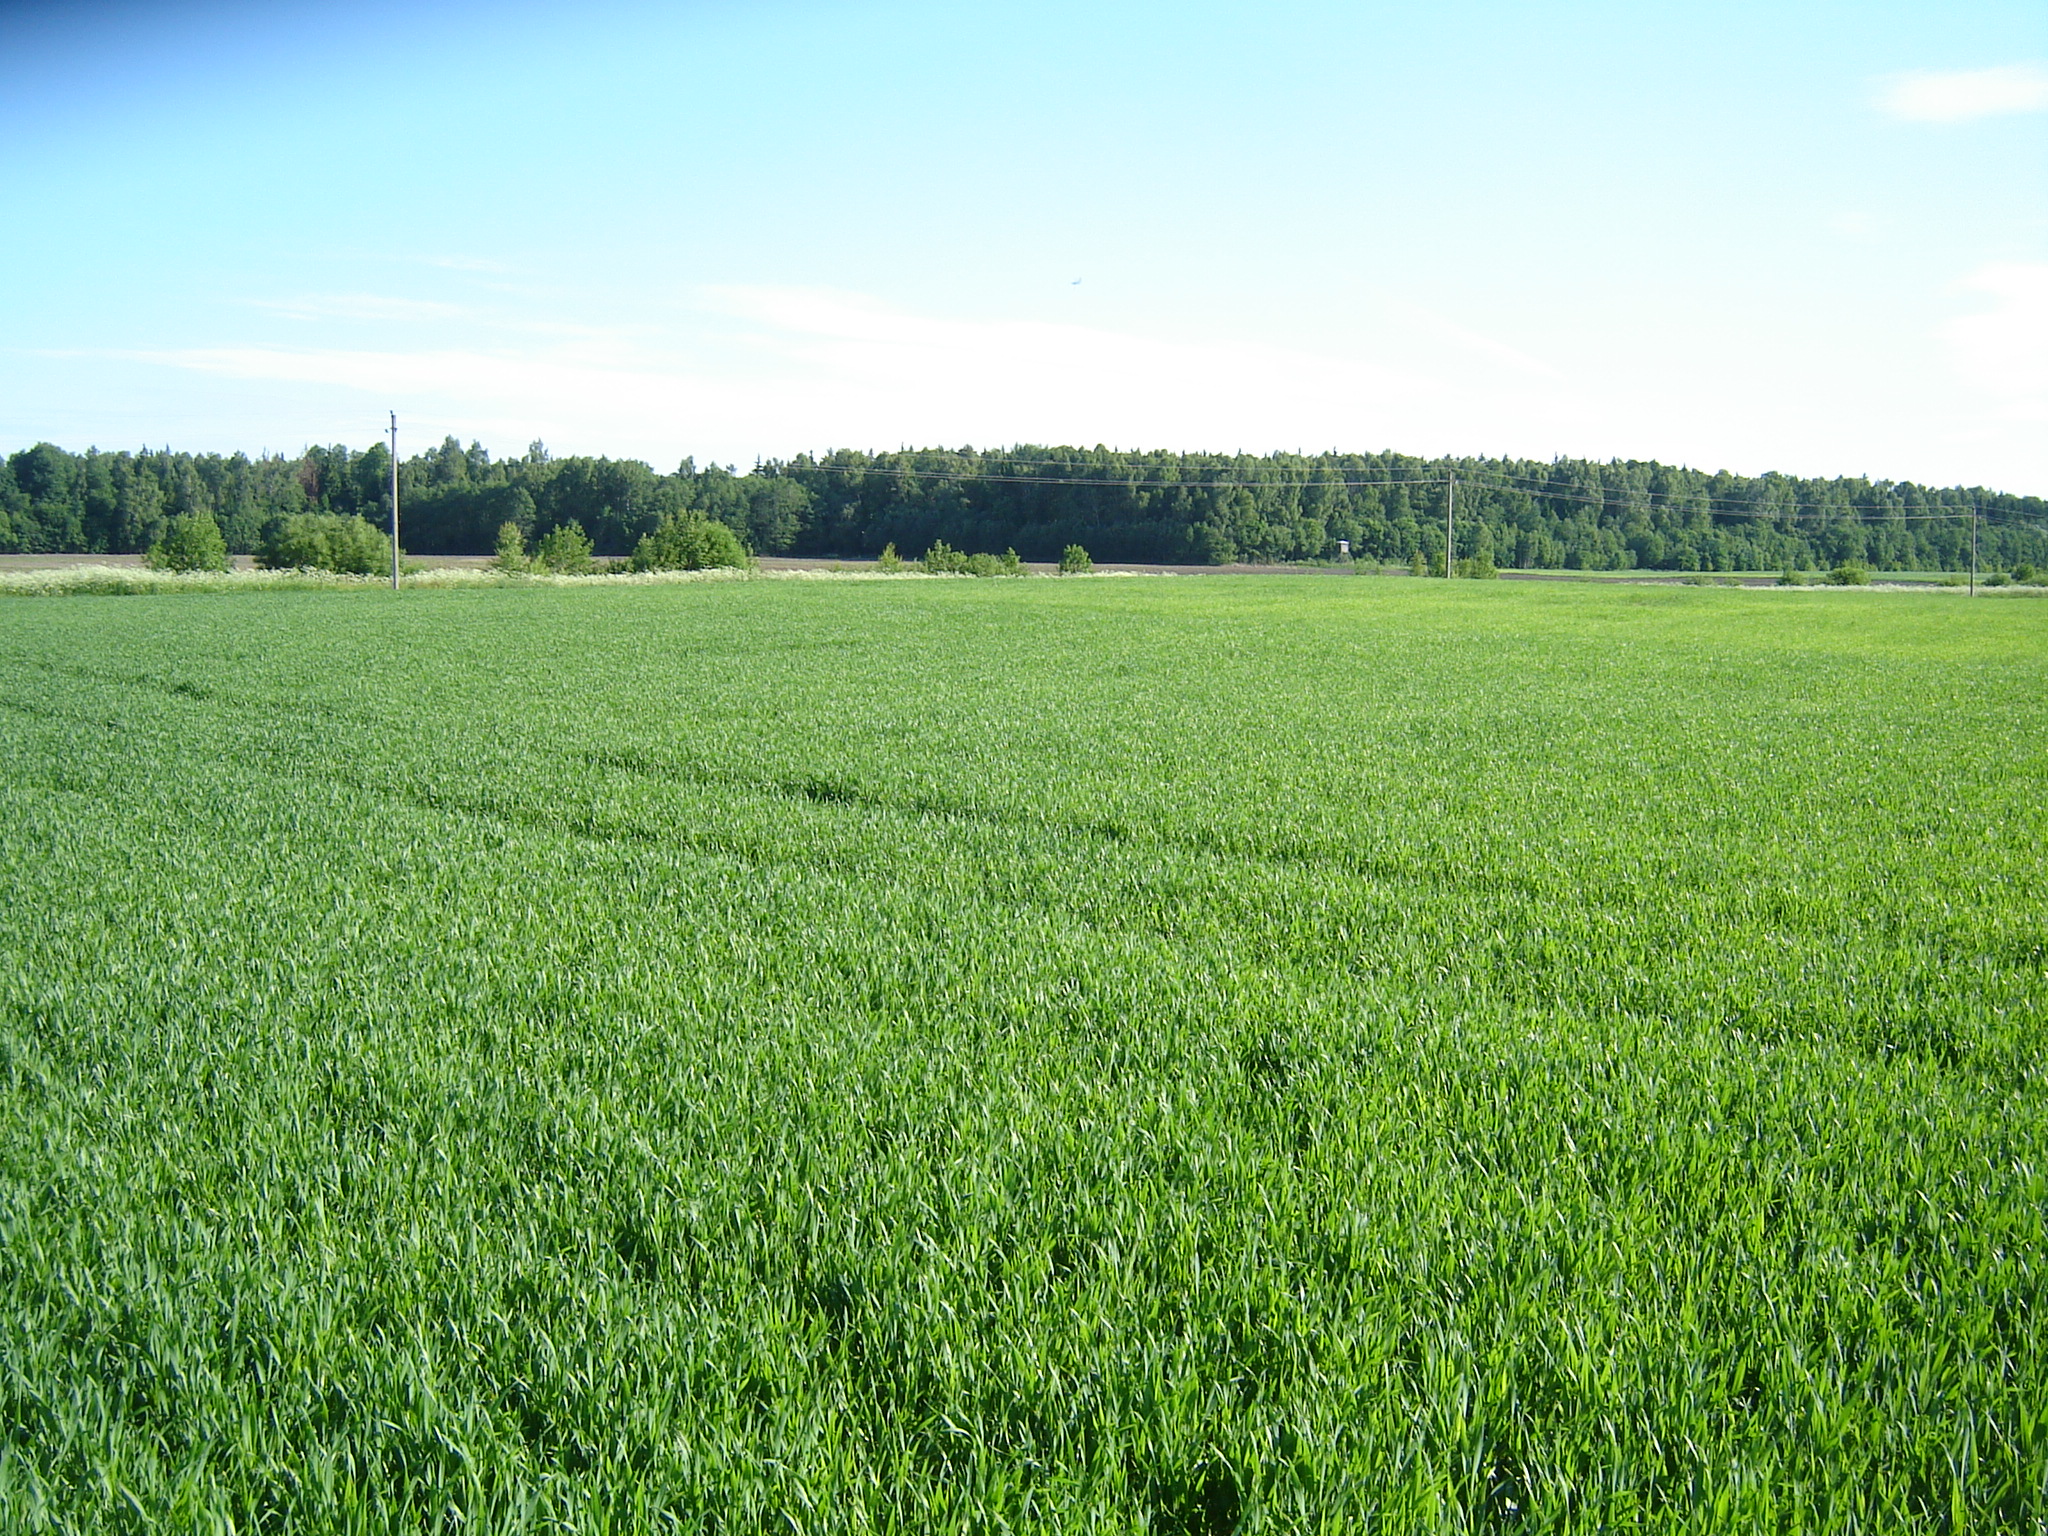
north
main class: Cropland
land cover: Common wheat
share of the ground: > 75 %
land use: Agriculture (excluding fallow land and kitchen gardens)
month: June
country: LT
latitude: 55.5252
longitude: 24.7912
